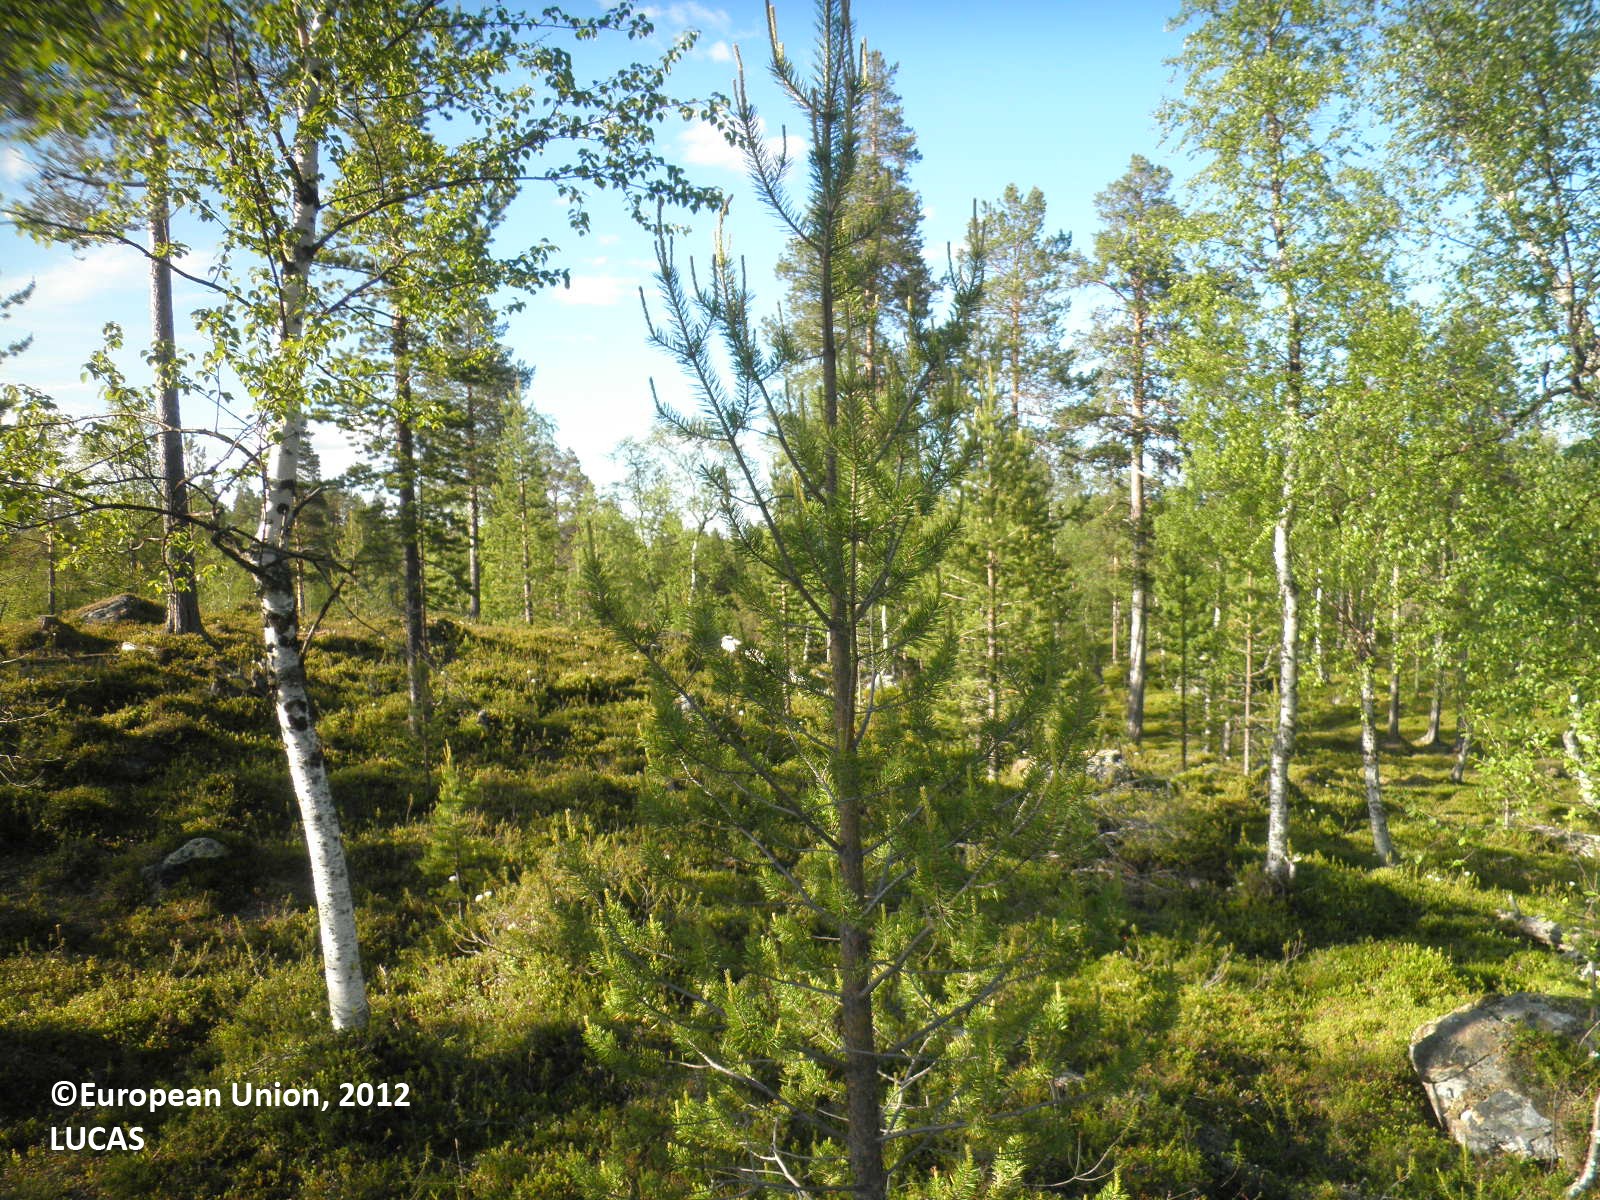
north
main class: Woodland
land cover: Pine dominated mixed woodland
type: boreal forest
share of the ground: 25 - 50 %
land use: Forestry
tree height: > 5 m
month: July
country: FI
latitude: 68.8534
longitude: 27.2295
